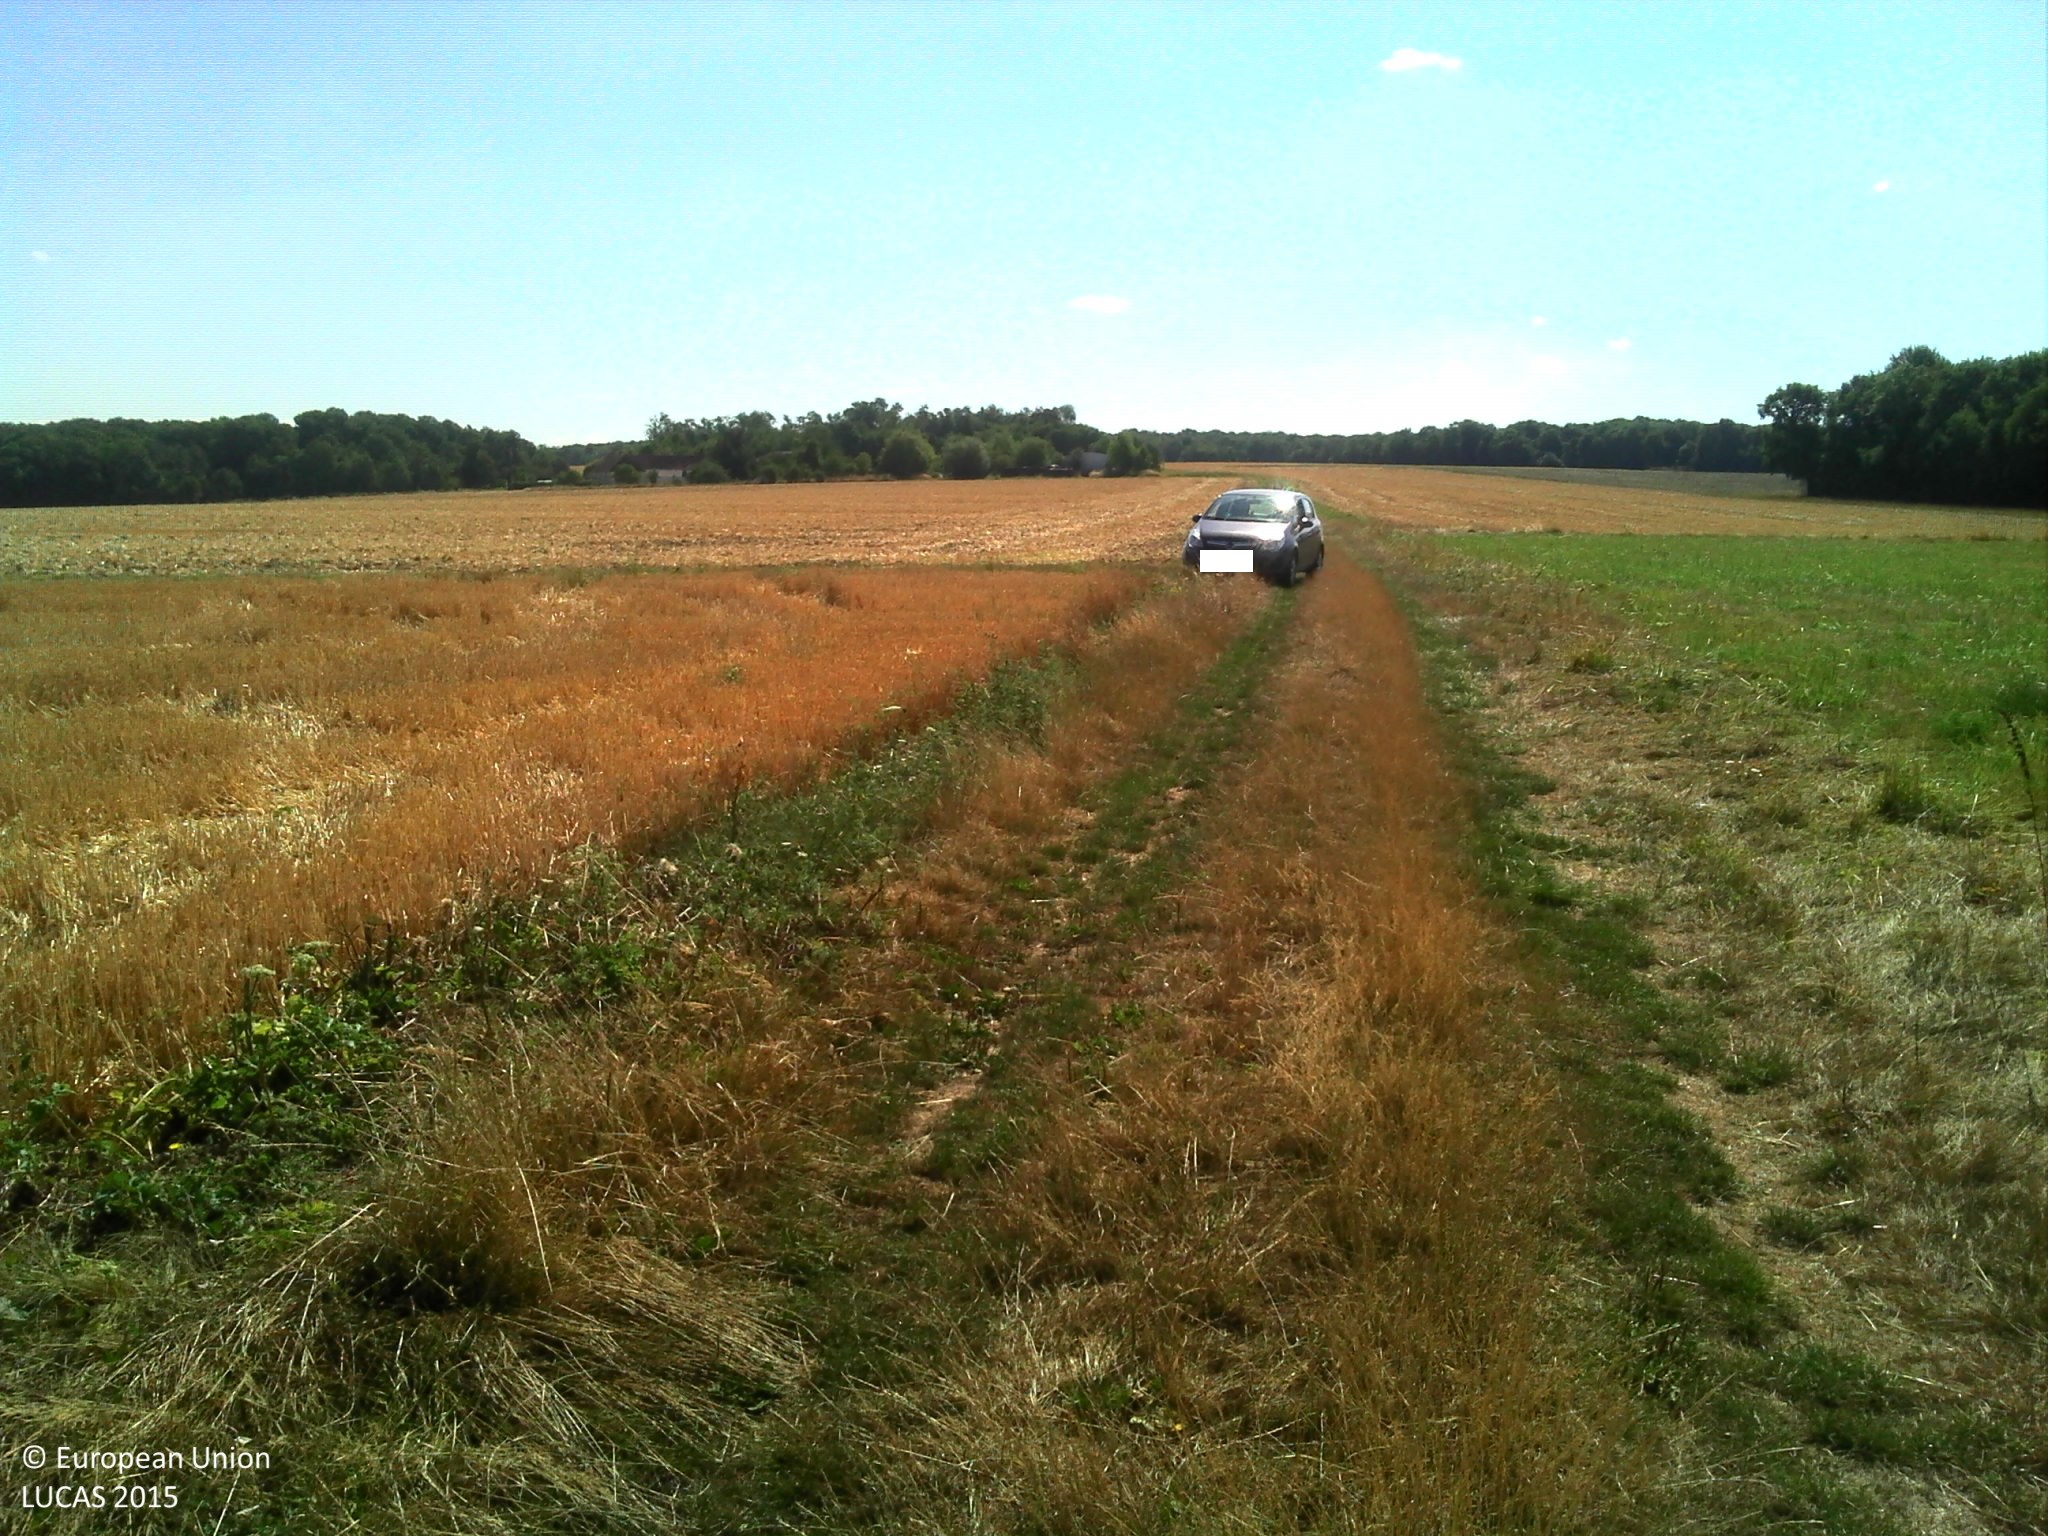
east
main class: Artificial land
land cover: Non built-up linear features
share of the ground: > 75 %
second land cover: Grassland without tree/shrub cover
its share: > 75 %
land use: Road transport
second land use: Agriculture (excluding fallow land and kitchen gardens)
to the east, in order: Tracks; Grassland without tree/shrub cover; Common wheat; Tracks; Common wheat
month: August
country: FR
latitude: 48.7444
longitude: 3.3429
